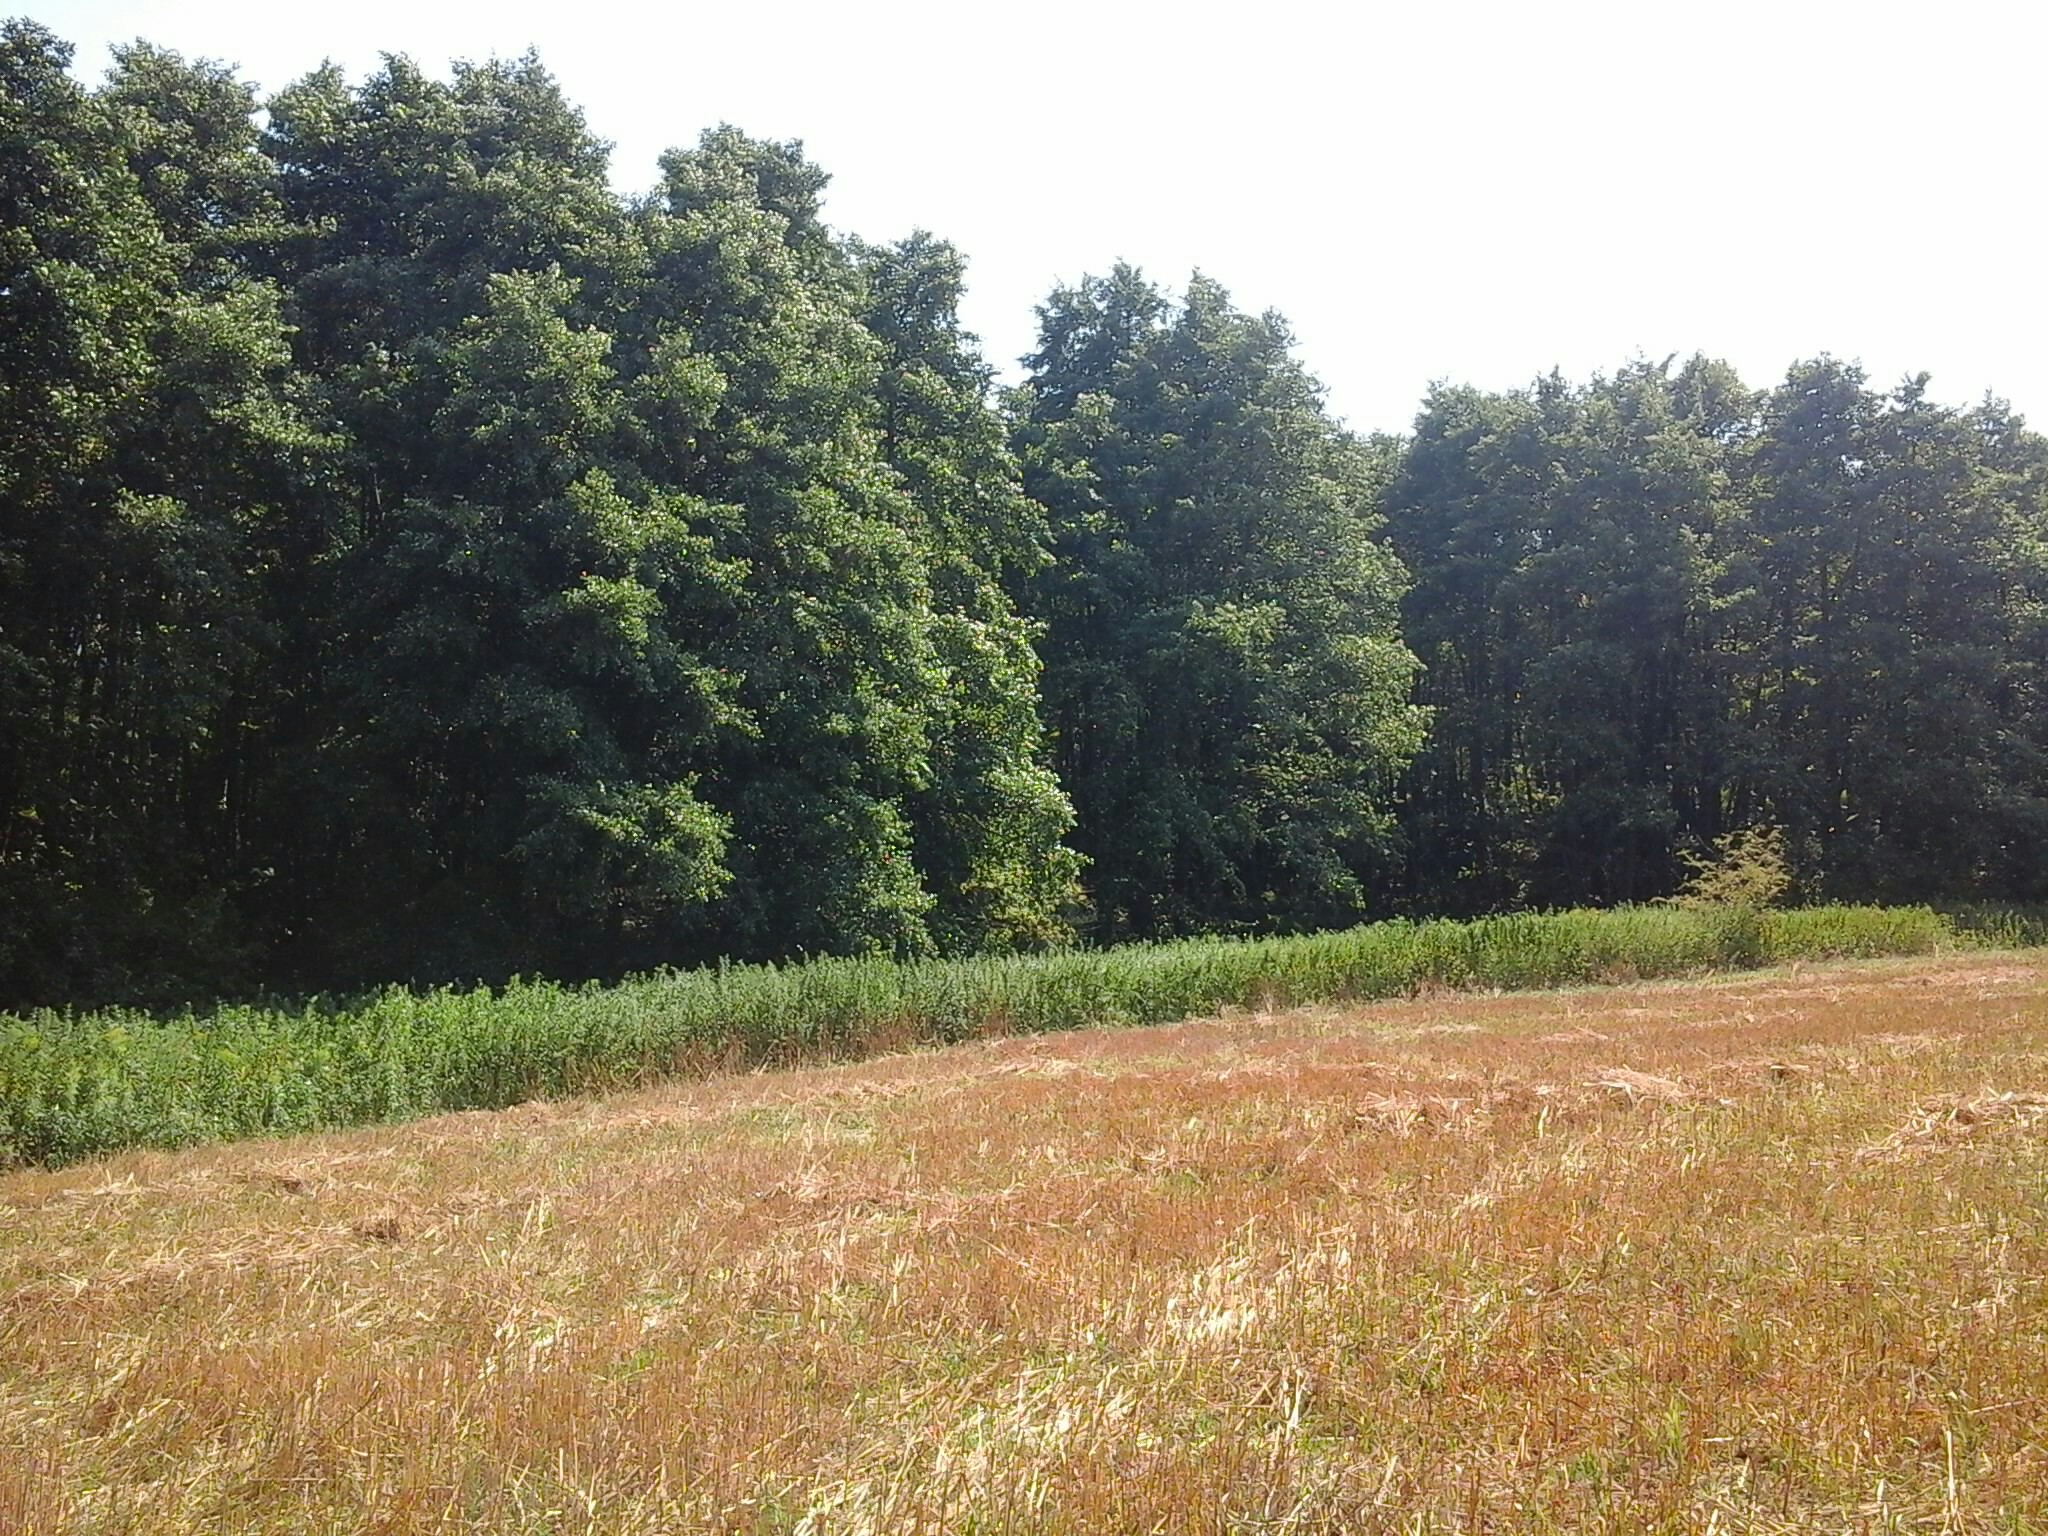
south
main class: Cropland
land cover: Common wheat
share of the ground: 50 - 75 %
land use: Agriculture (excluding fallow land and kitchen gardens)
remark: Harvested field
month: August
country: HU
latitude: 47.4220
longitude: 18.0570
